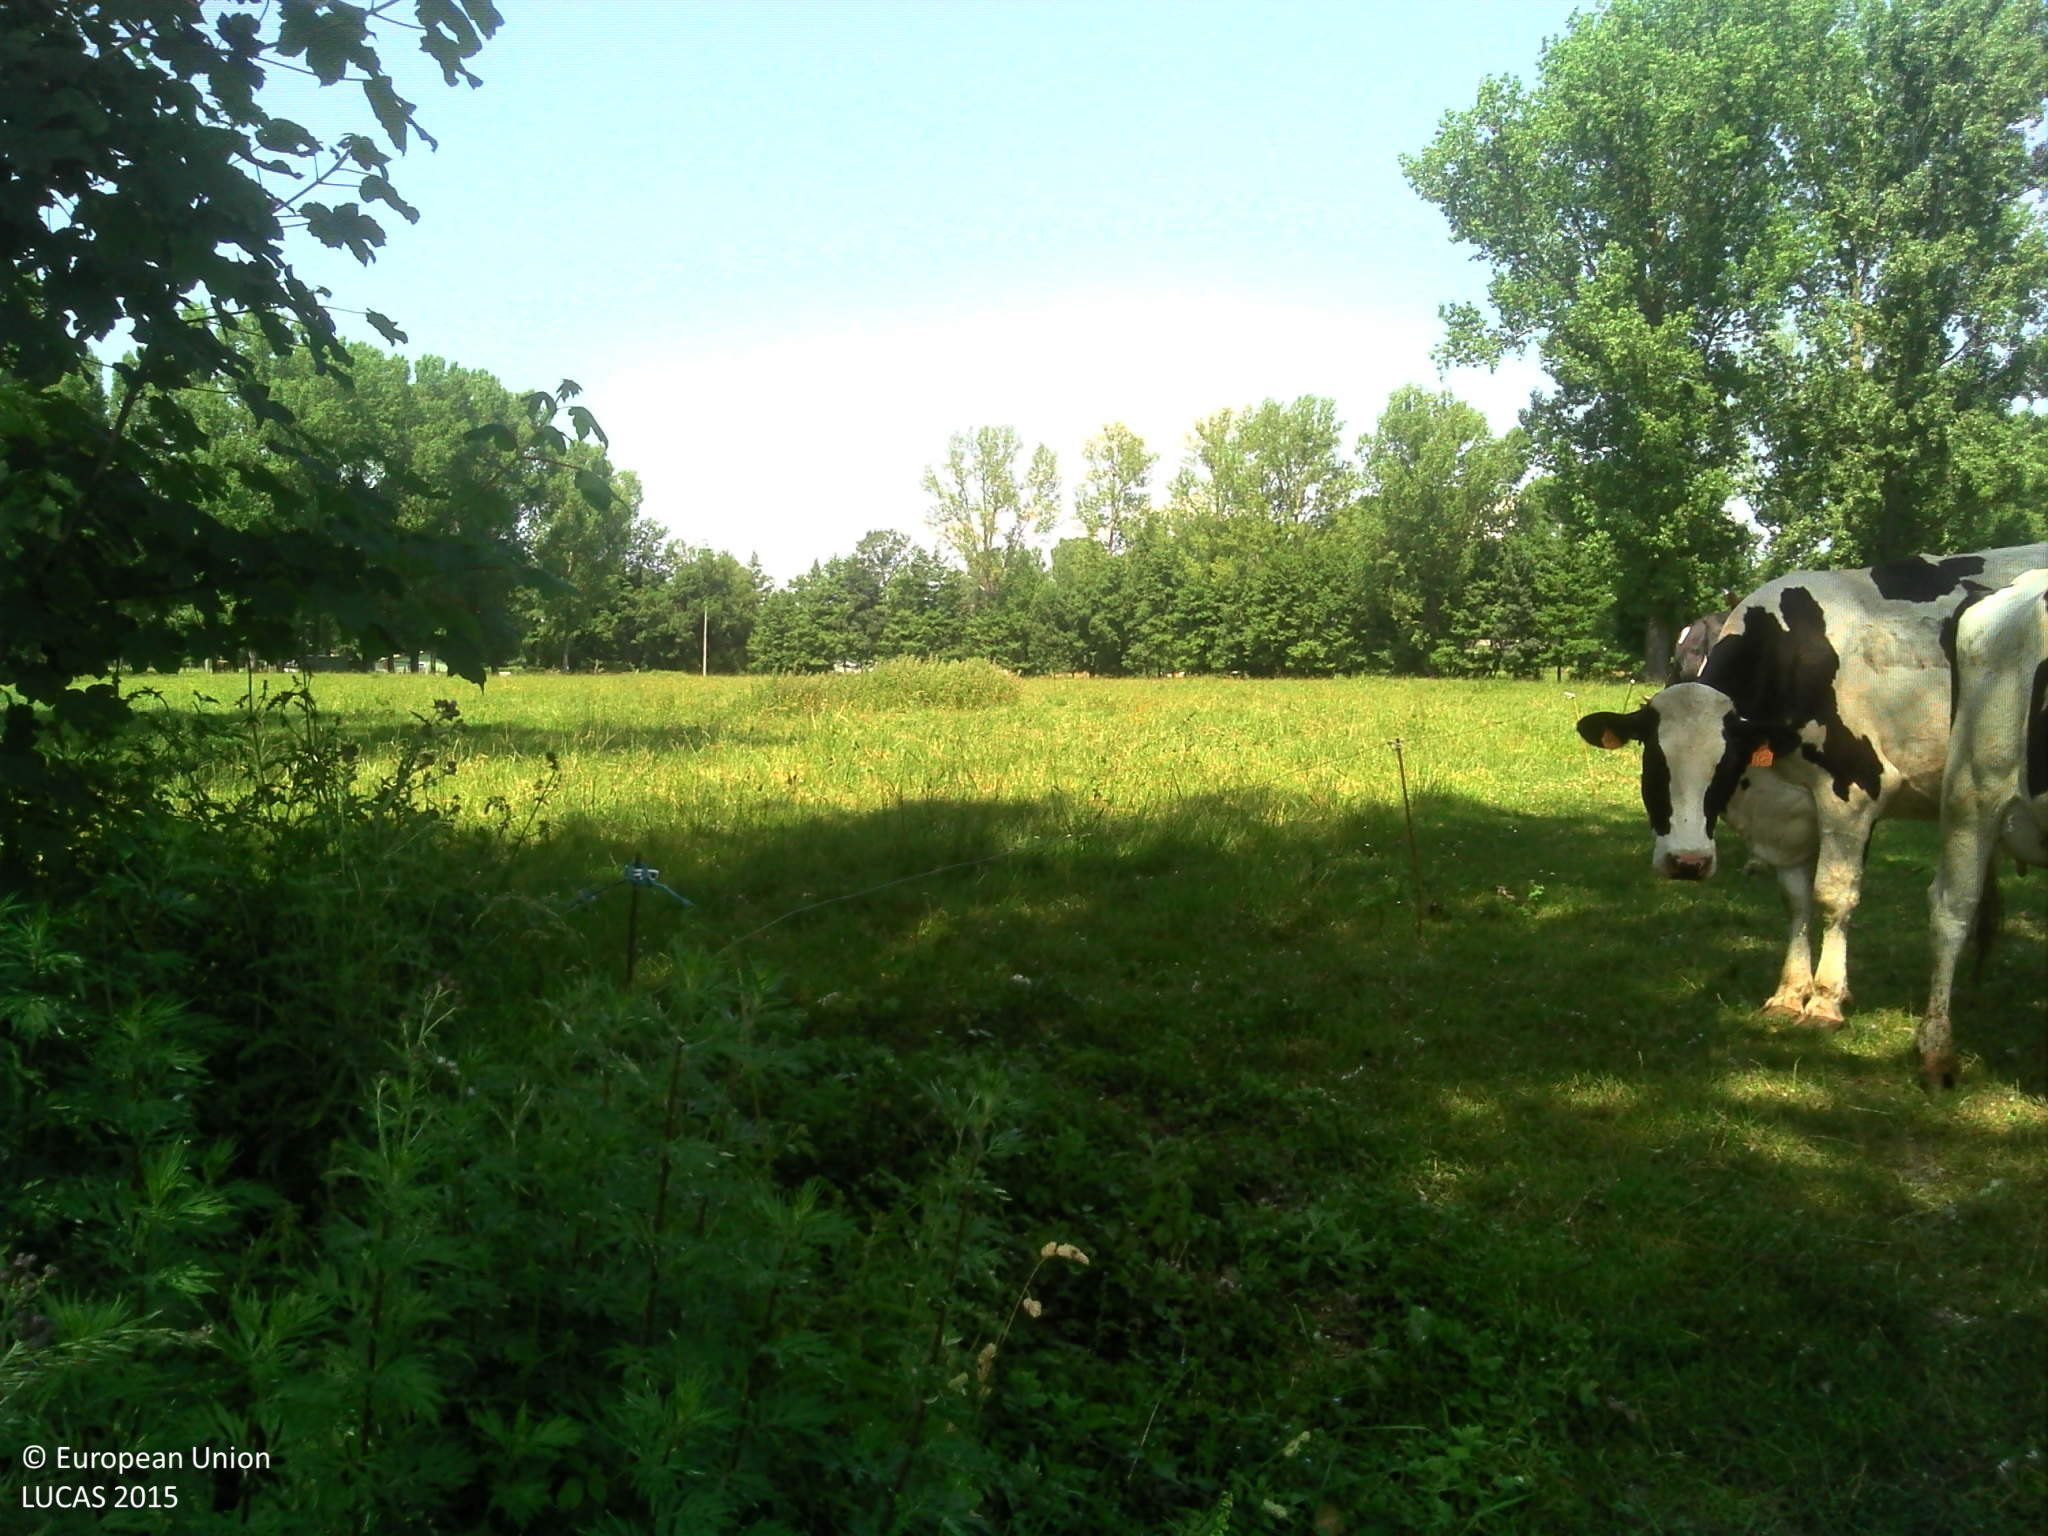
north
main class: Grassland
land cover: Grassland without tree/shrub cover
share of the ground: > 75 %
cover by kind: herbaceous plants 100 %
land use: Agriculture (excluding fallow land and kitchen gardens)
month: June
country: FR
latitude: 43.5274
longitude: 2.1489
